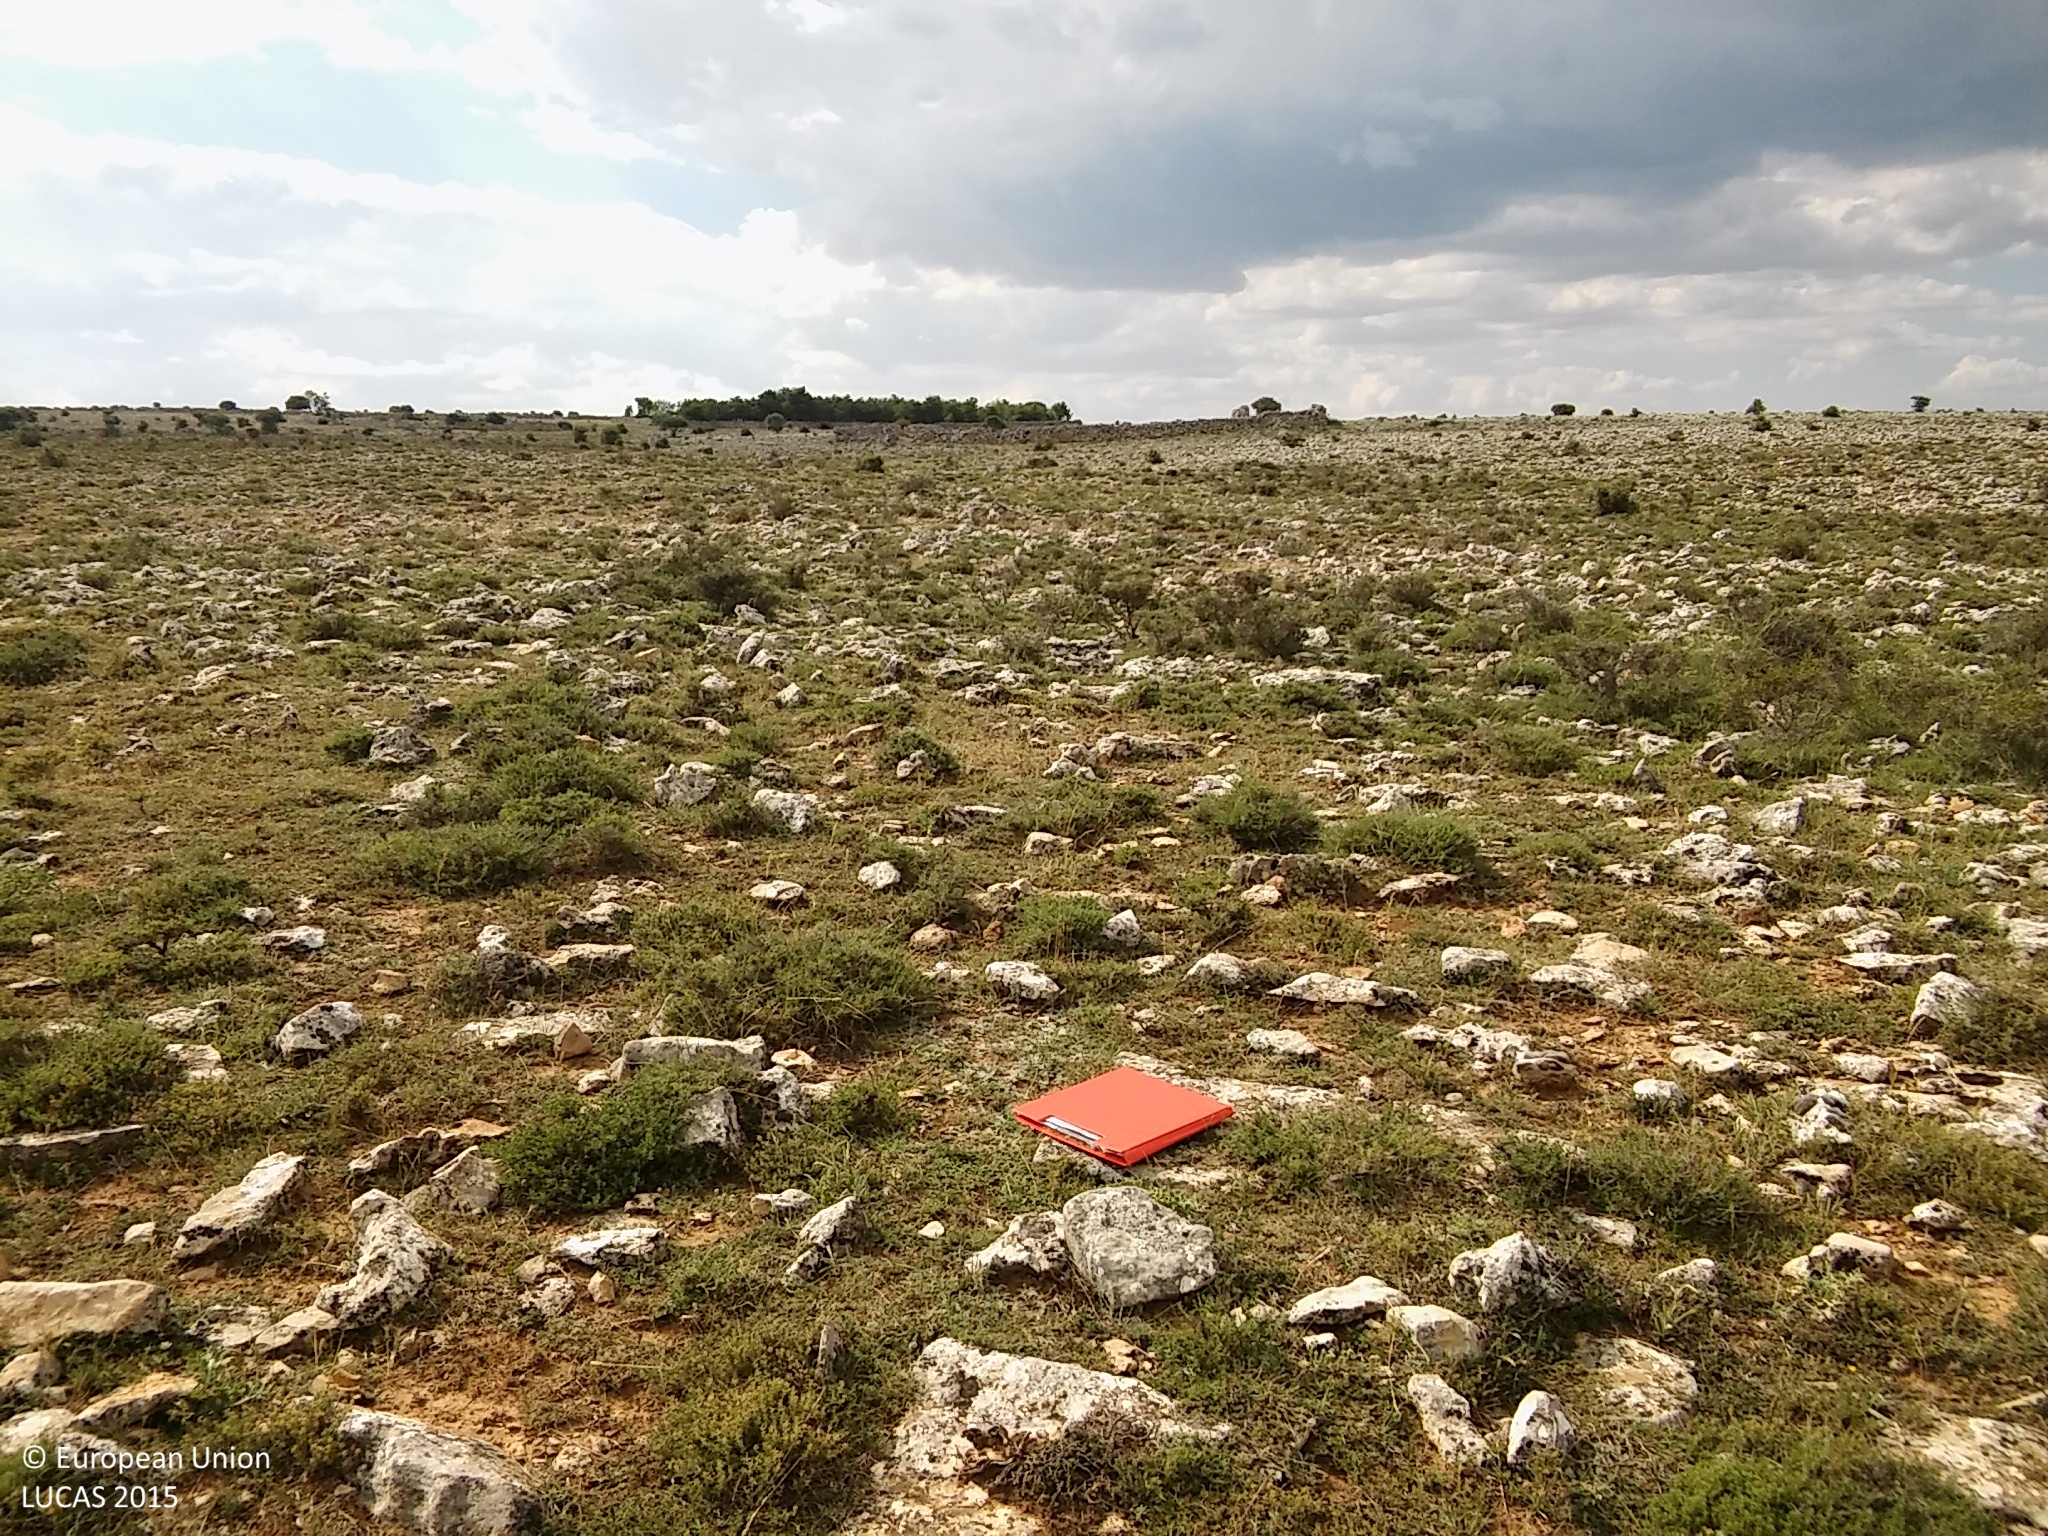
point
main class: Shrubland
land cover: Shrubland without tree cover
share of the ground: 25 - 50 %
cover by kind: unconsolidated bare surface 45 %, herbaceous plants 30 %, shrubs 25 %
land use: Semi-natural and natural areas not in use
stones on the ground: > 50 %
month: June
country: ES
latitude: 41.3475
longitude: -3.7340
